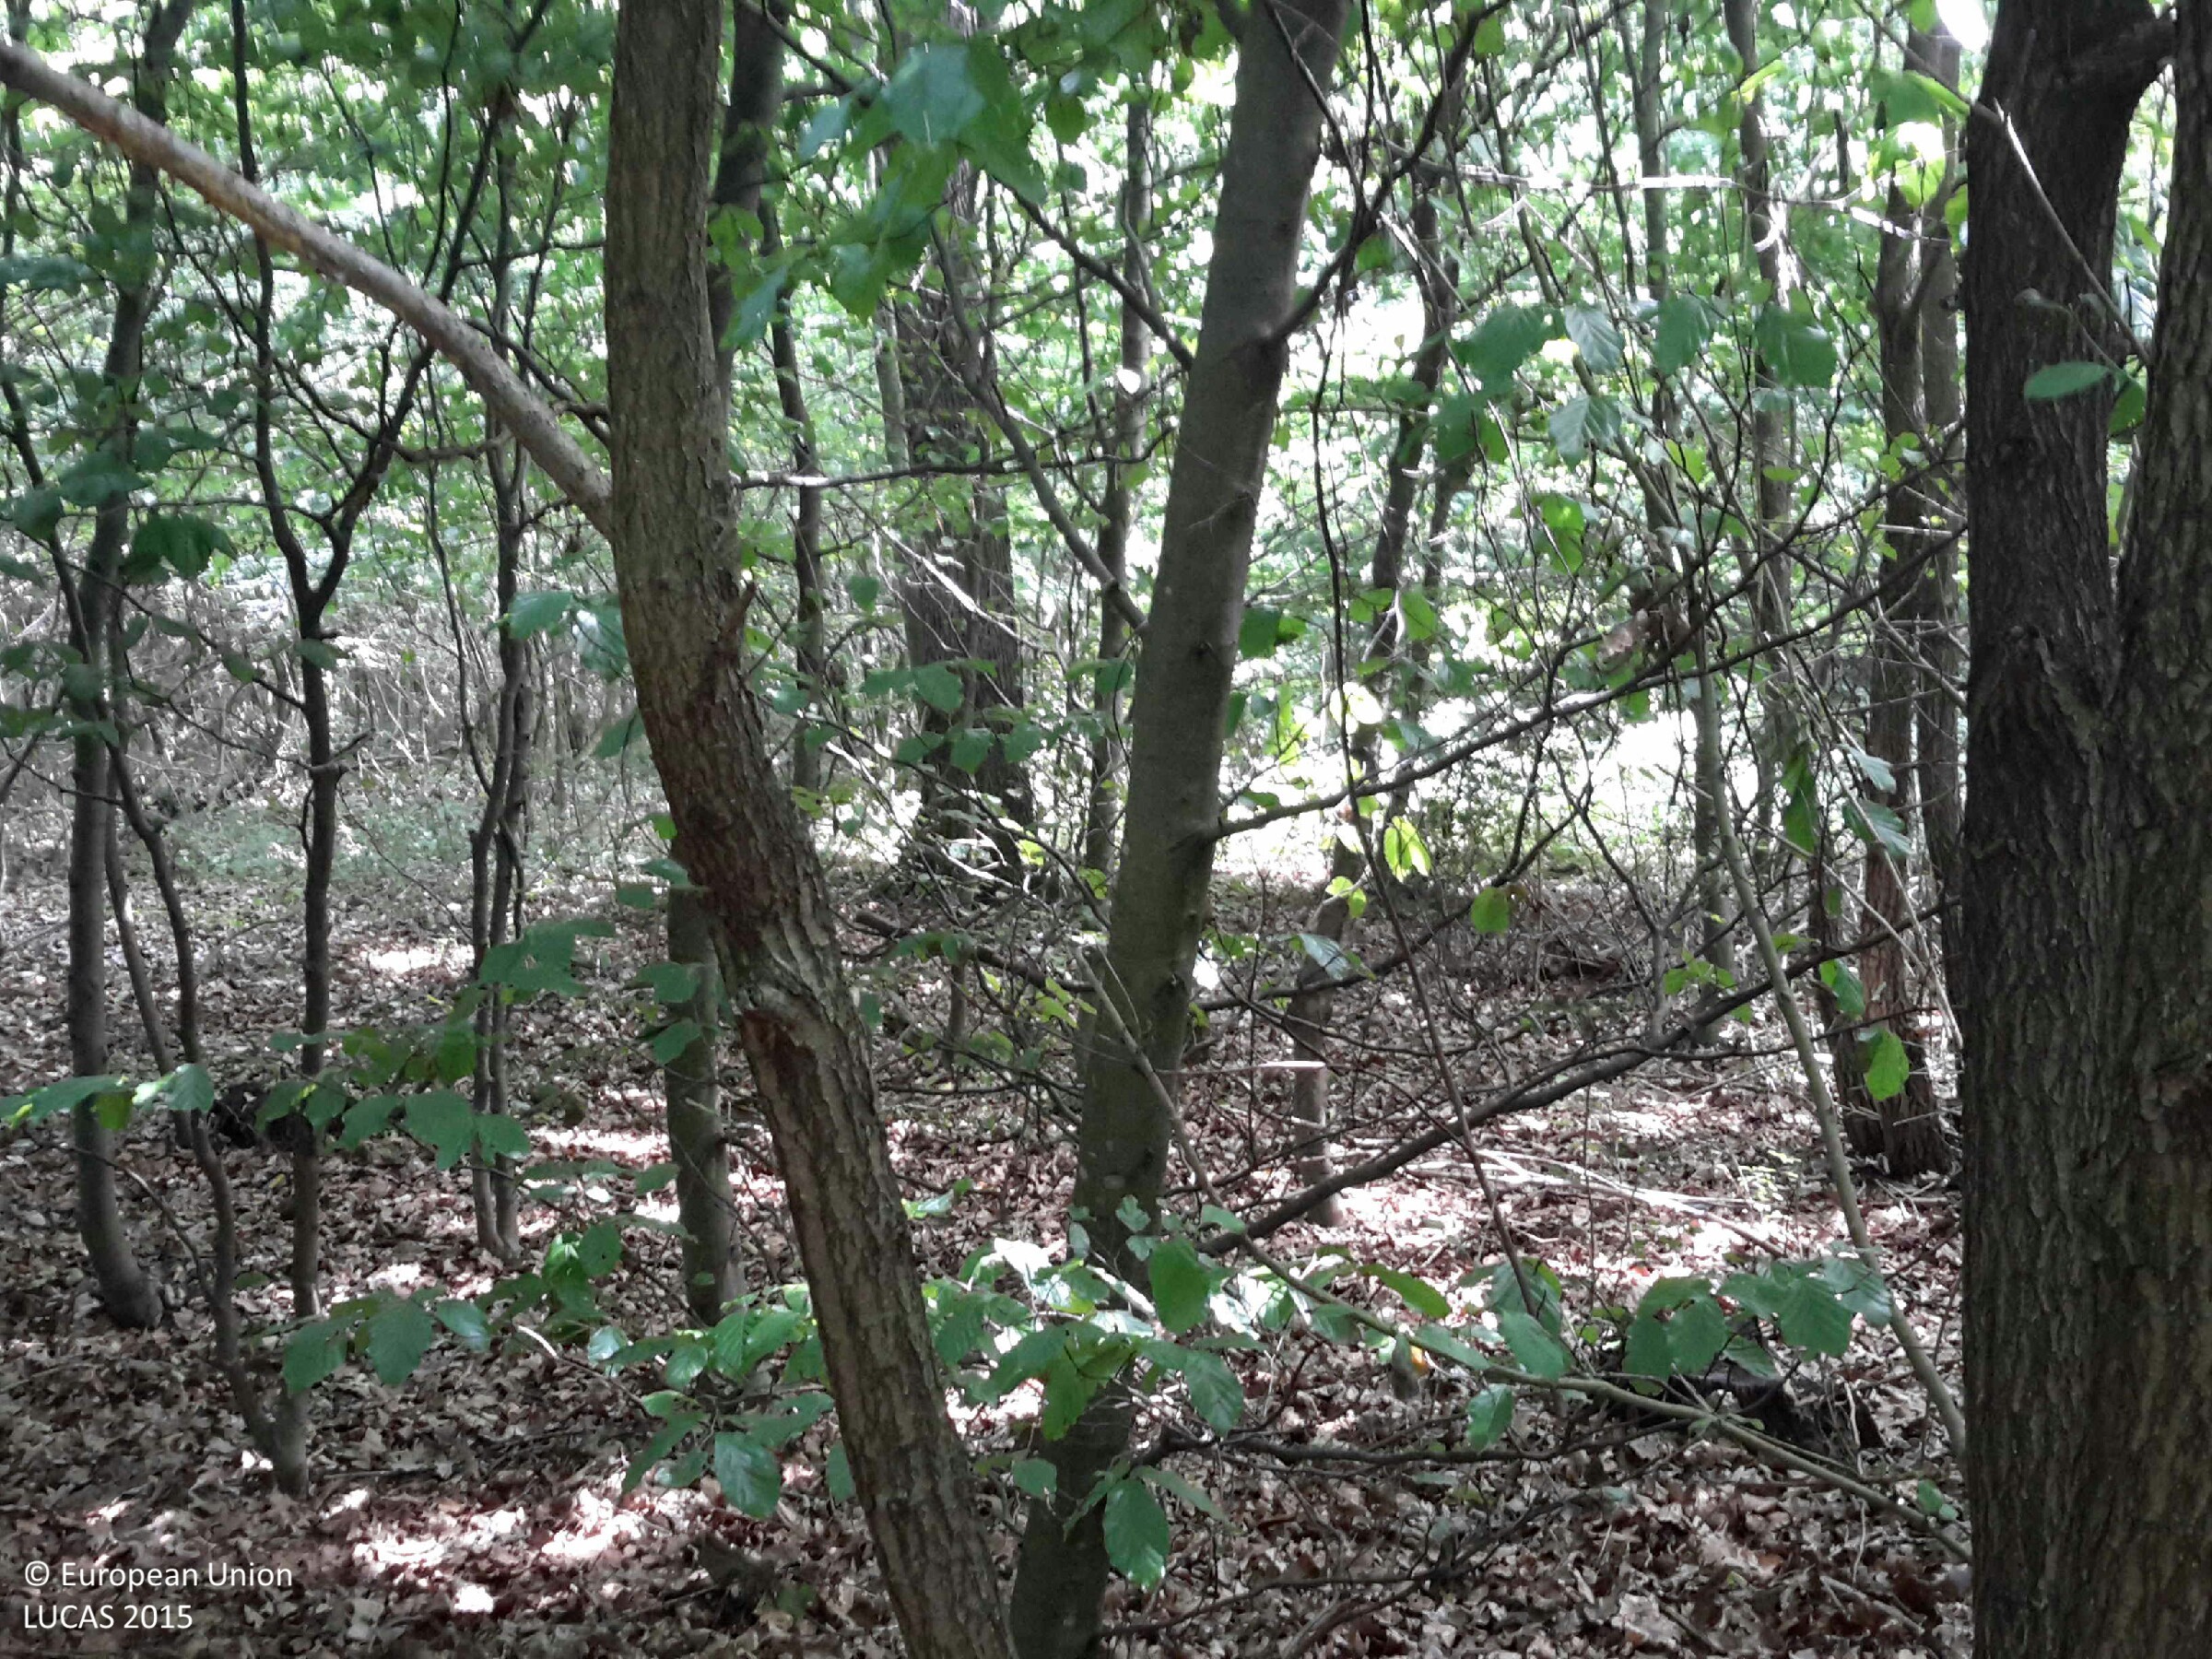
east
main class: Woodland
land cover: Broadleaved woodland
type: beech forest
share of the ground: > 75 %
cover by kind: broadleaved forest trees 100 %
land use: Forestry
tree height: > 5 m
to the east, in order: Broadleaved woodland; Shrubland with sparse tree cover; Fences; Maize
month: July
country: HU
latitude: 47.1810
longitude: 16.5350
